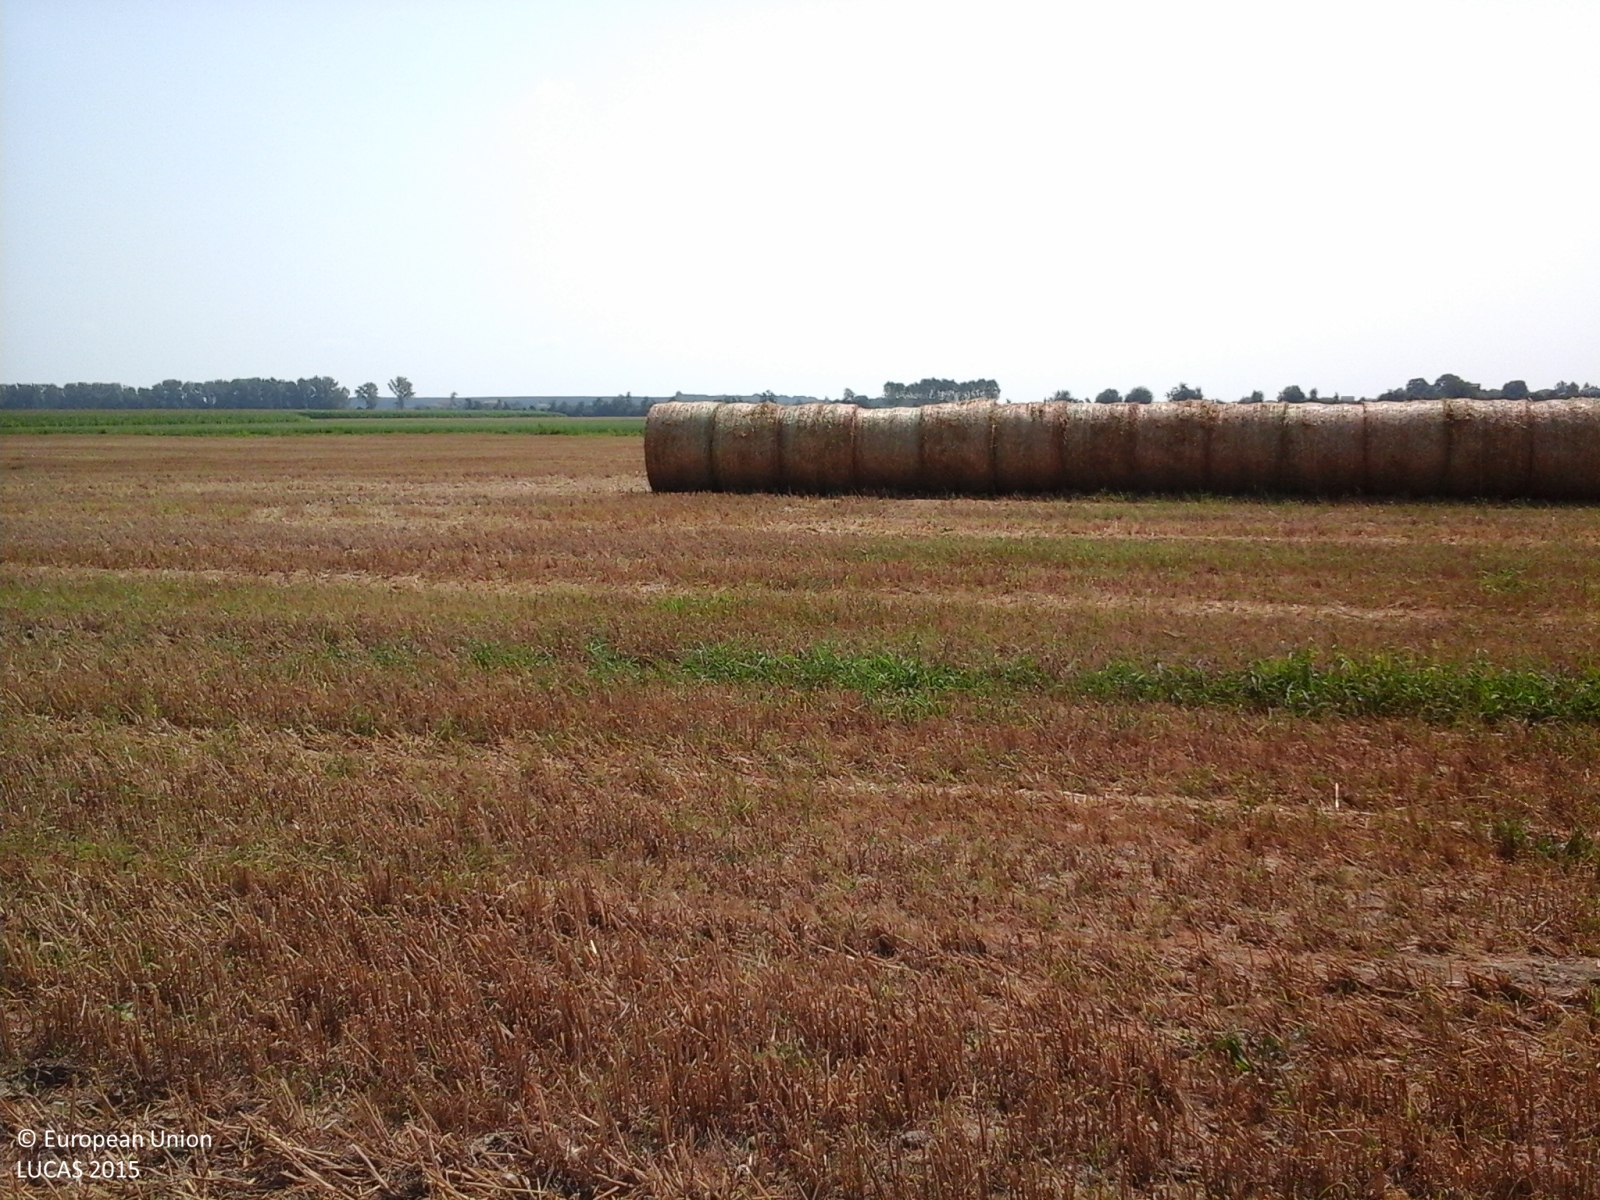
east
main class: Cropland
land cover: Maize
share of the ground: > 75 %
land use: Agriculture (excluding fallow land and kitchen gardens)
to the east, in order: Maize; Grass margins; Ditches and canals; Common wheat; Grass margins; Ditches and canals; Grass margins; Spontaneously vegetated surfaces
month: July
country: IT
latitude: 44.5900
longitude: 11.6467
